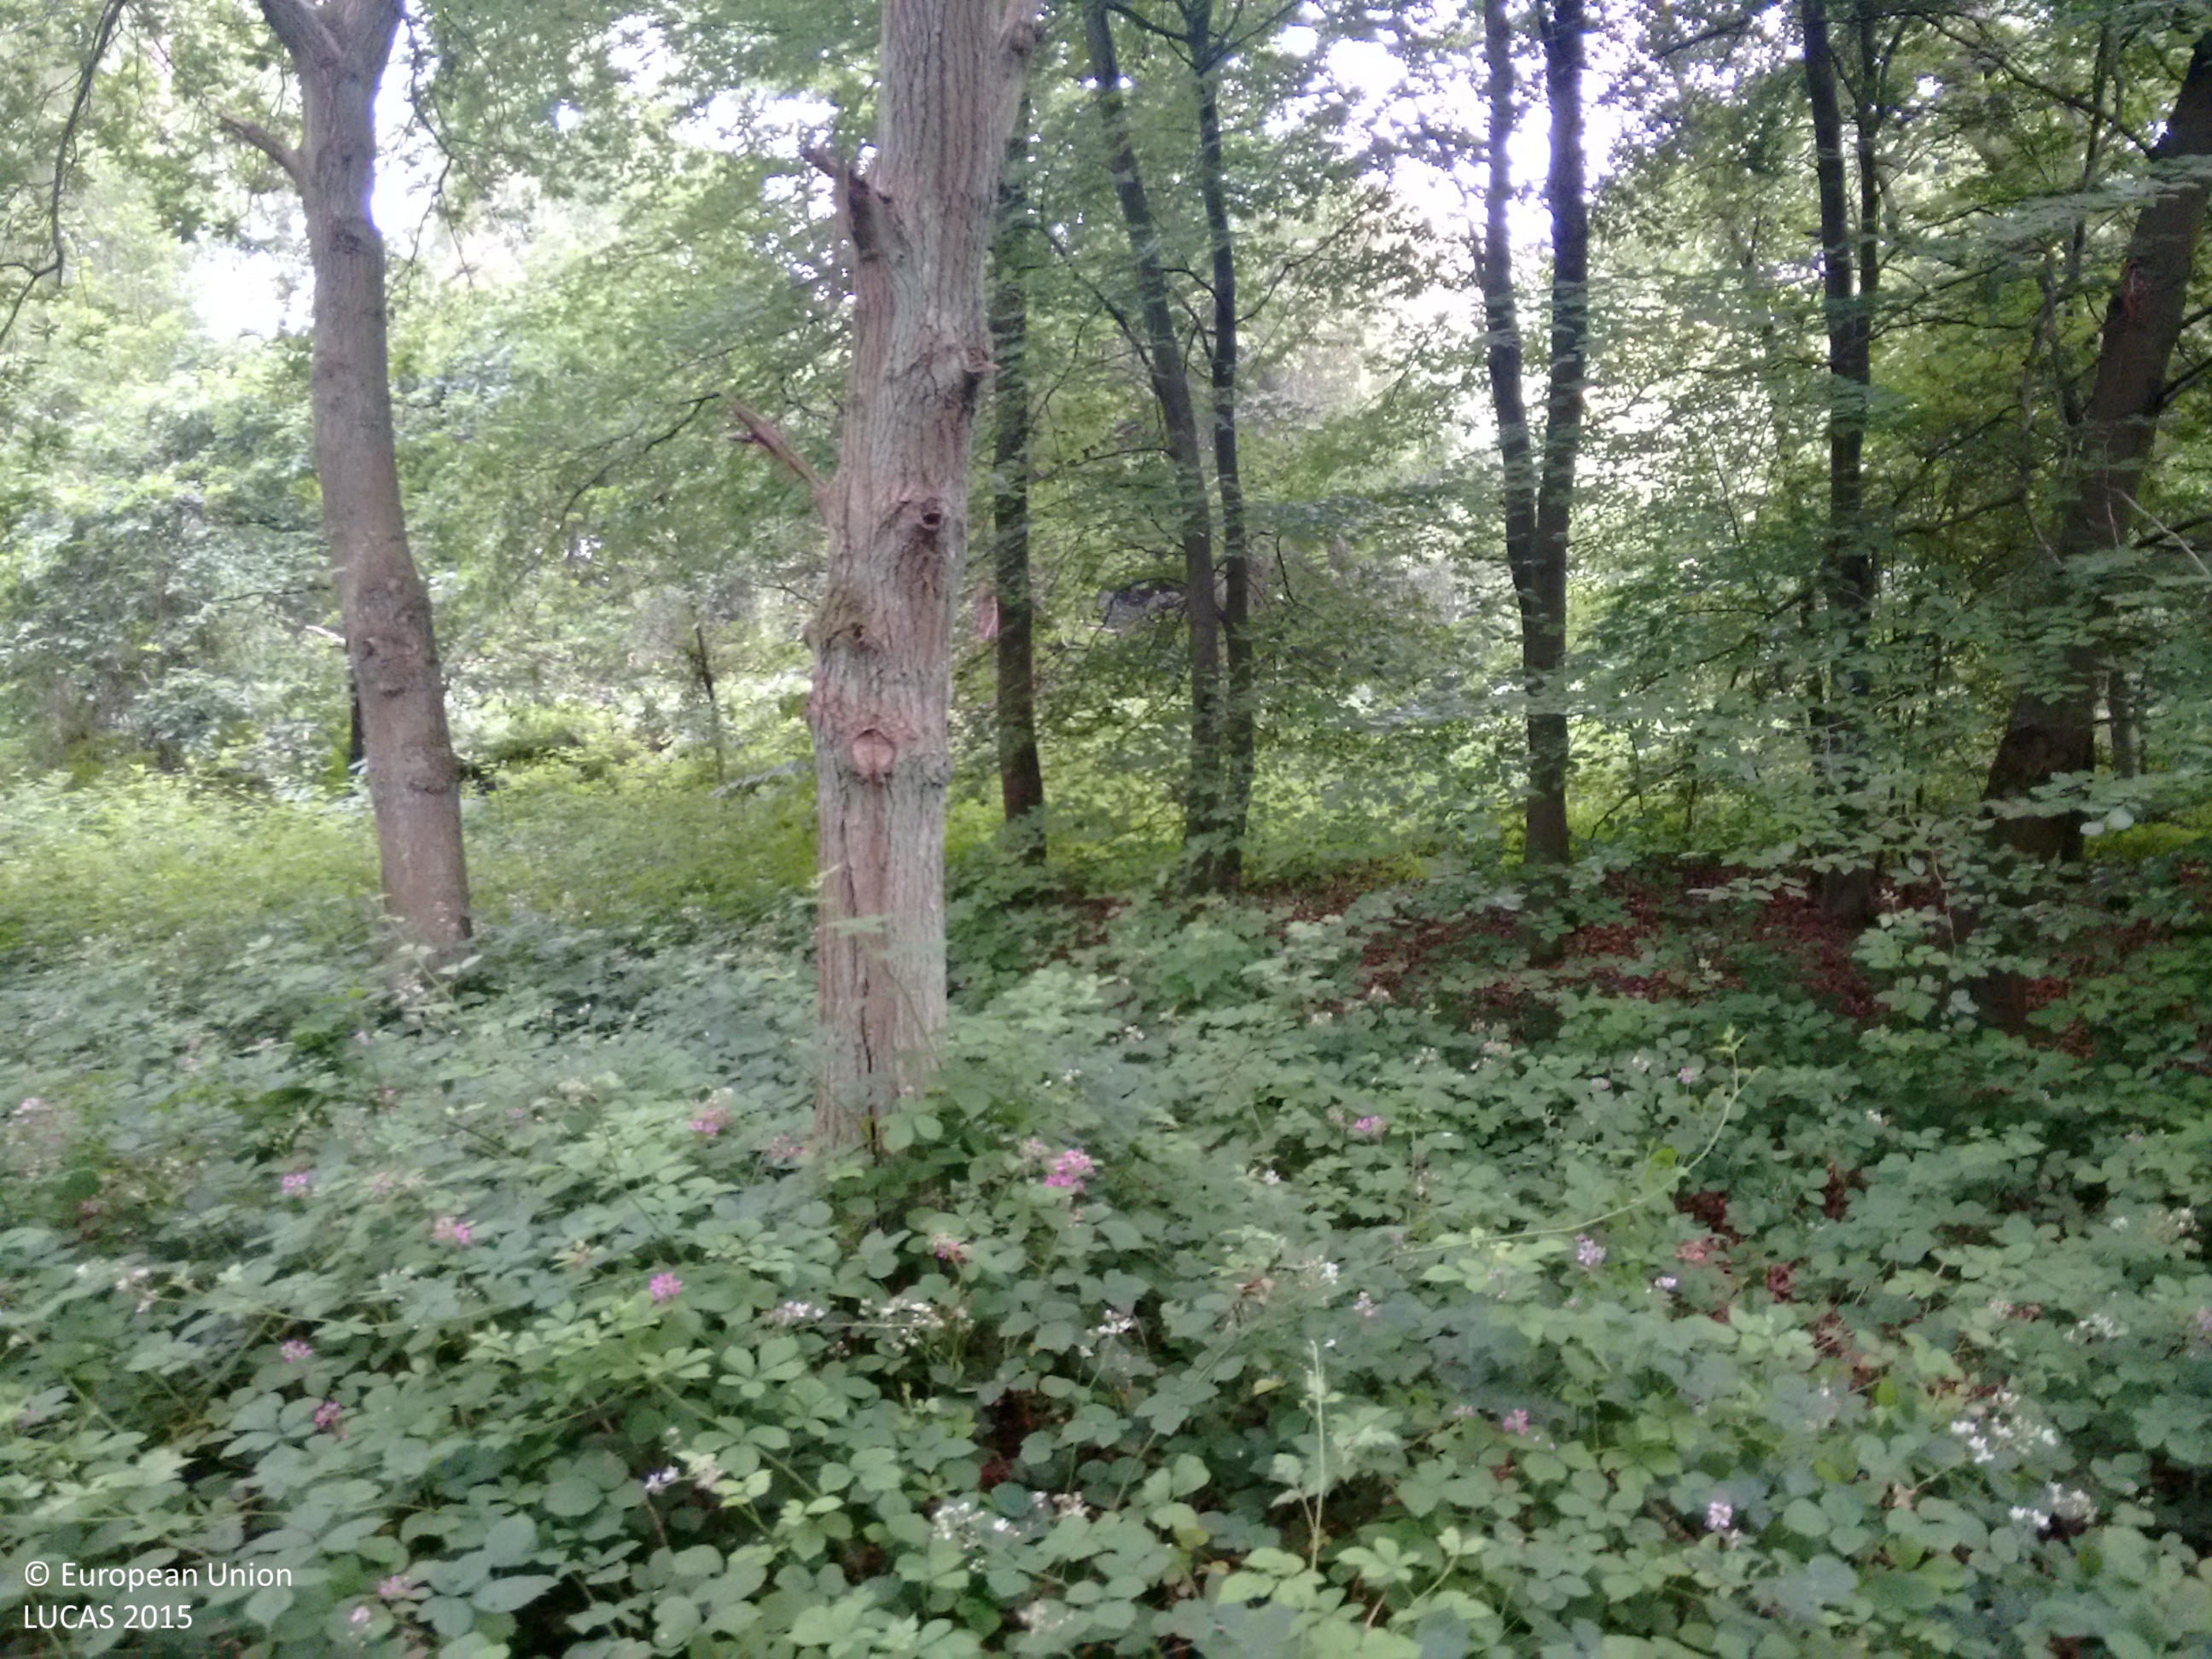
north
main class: Woodland
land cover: Broadleaved woodland
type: mesophytic deciduous forest
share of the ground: > 75 %
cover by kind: broadleaved forest trees 100 %
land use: Amenities, museums, leisure
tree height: > 5 m
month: July
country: GB
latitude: 53.2565
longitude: -1.0618
